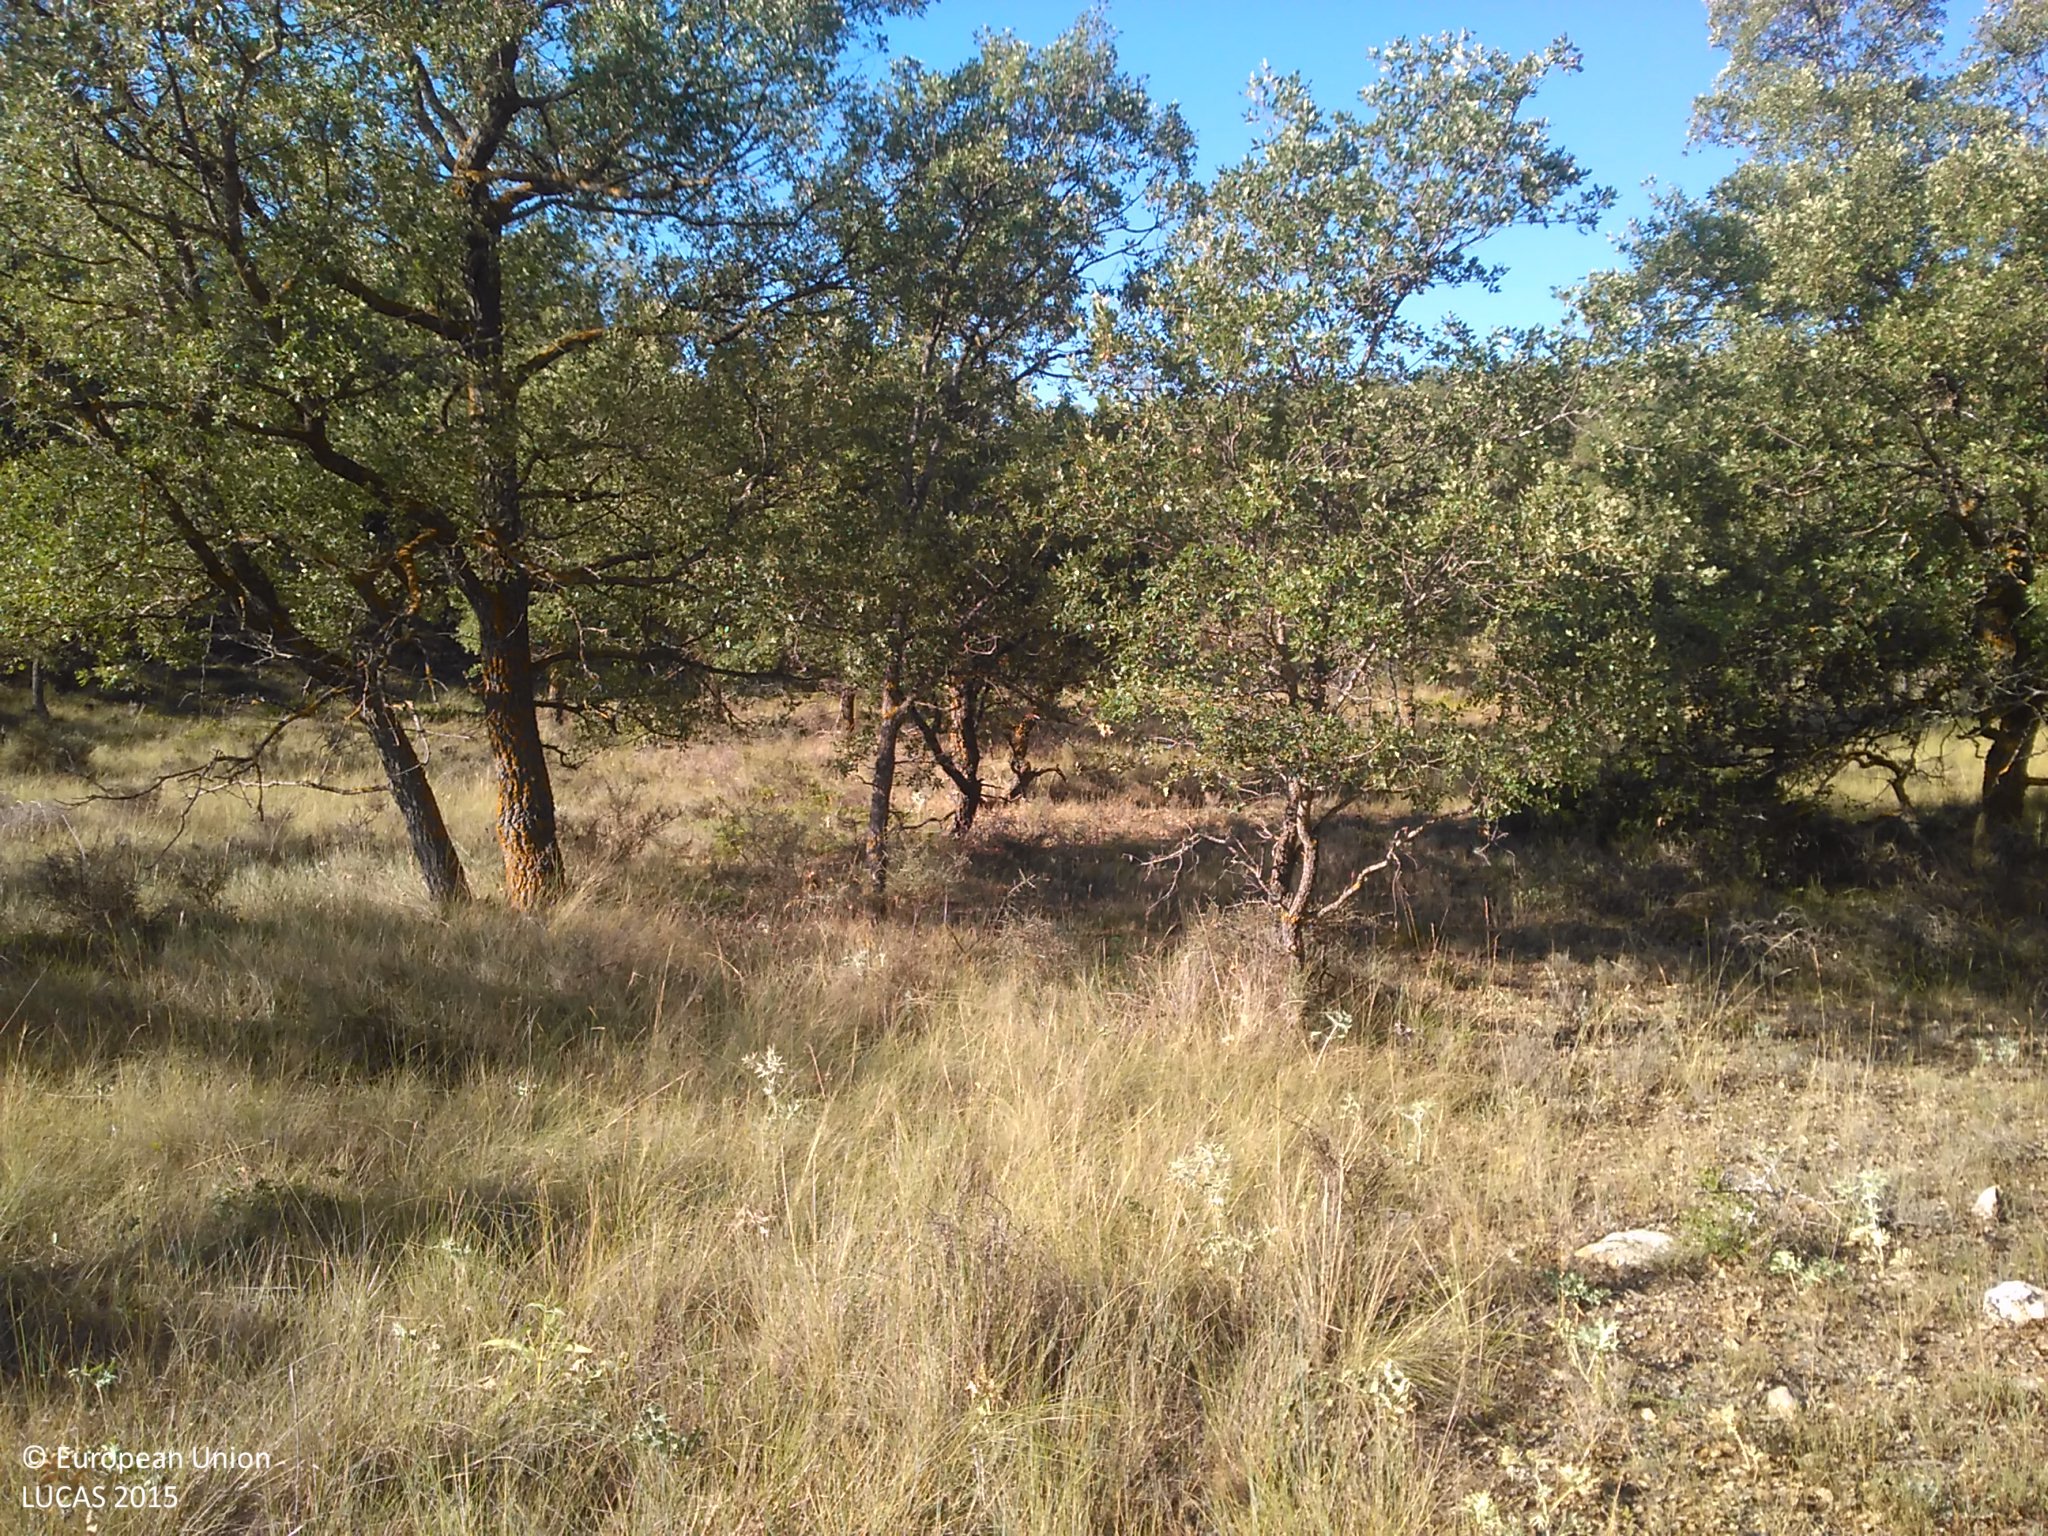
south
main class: Woodland
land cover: Broadleaved woodland
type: broadleaved evergreen forest
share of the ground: 25 - 50 %
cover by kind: broadleaved forest trees 40 %, herbaceous plants 35 %, unconsolidated bare surface 20 %, shrubs 5 %
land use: Semi-natural and natural areas not in use
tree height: > 5 m
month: July
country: ES
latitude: 41.5008
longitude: -2.1431
